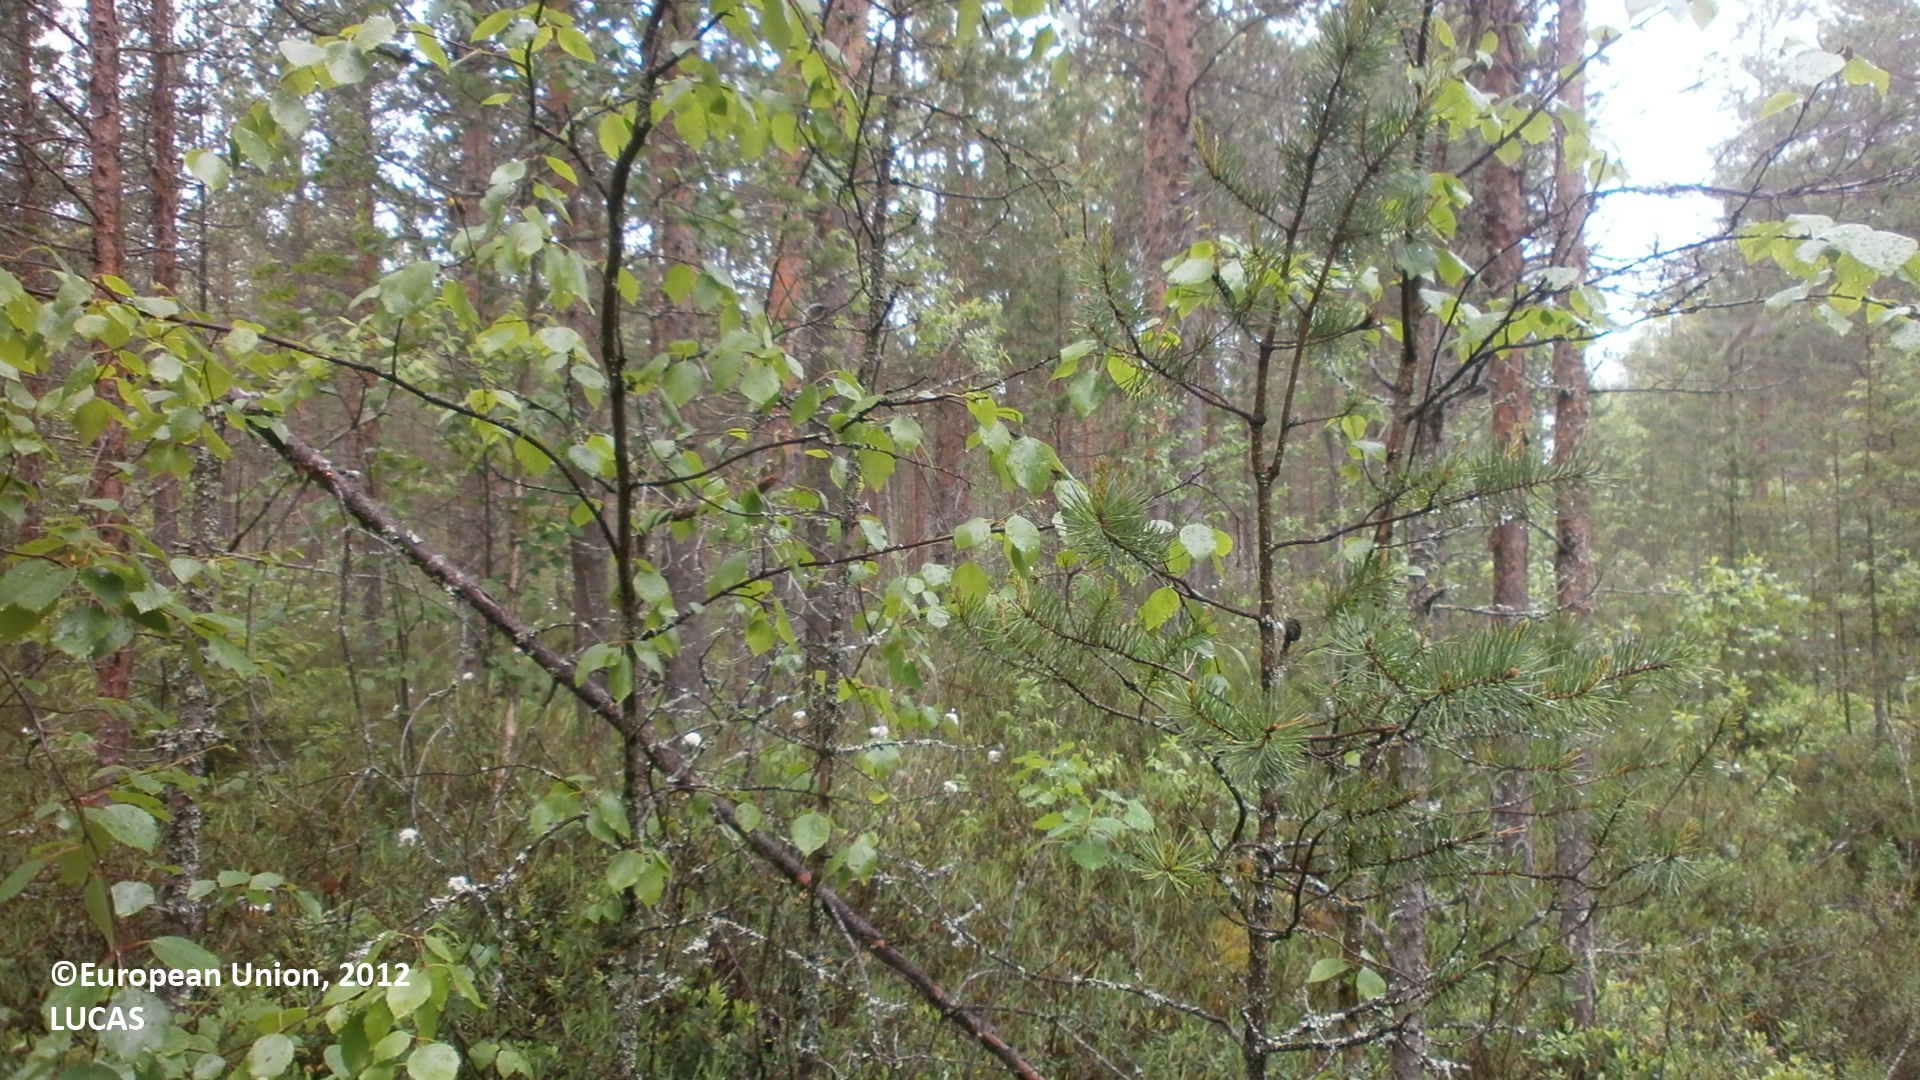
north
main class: Woodland
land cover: Pine dominated coniferous woodland
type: mire and swamp forests
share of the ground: > 75 %
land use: Forestry
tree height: > 5 m
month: June
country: FI
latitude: 64.7782
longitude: 25.2884
